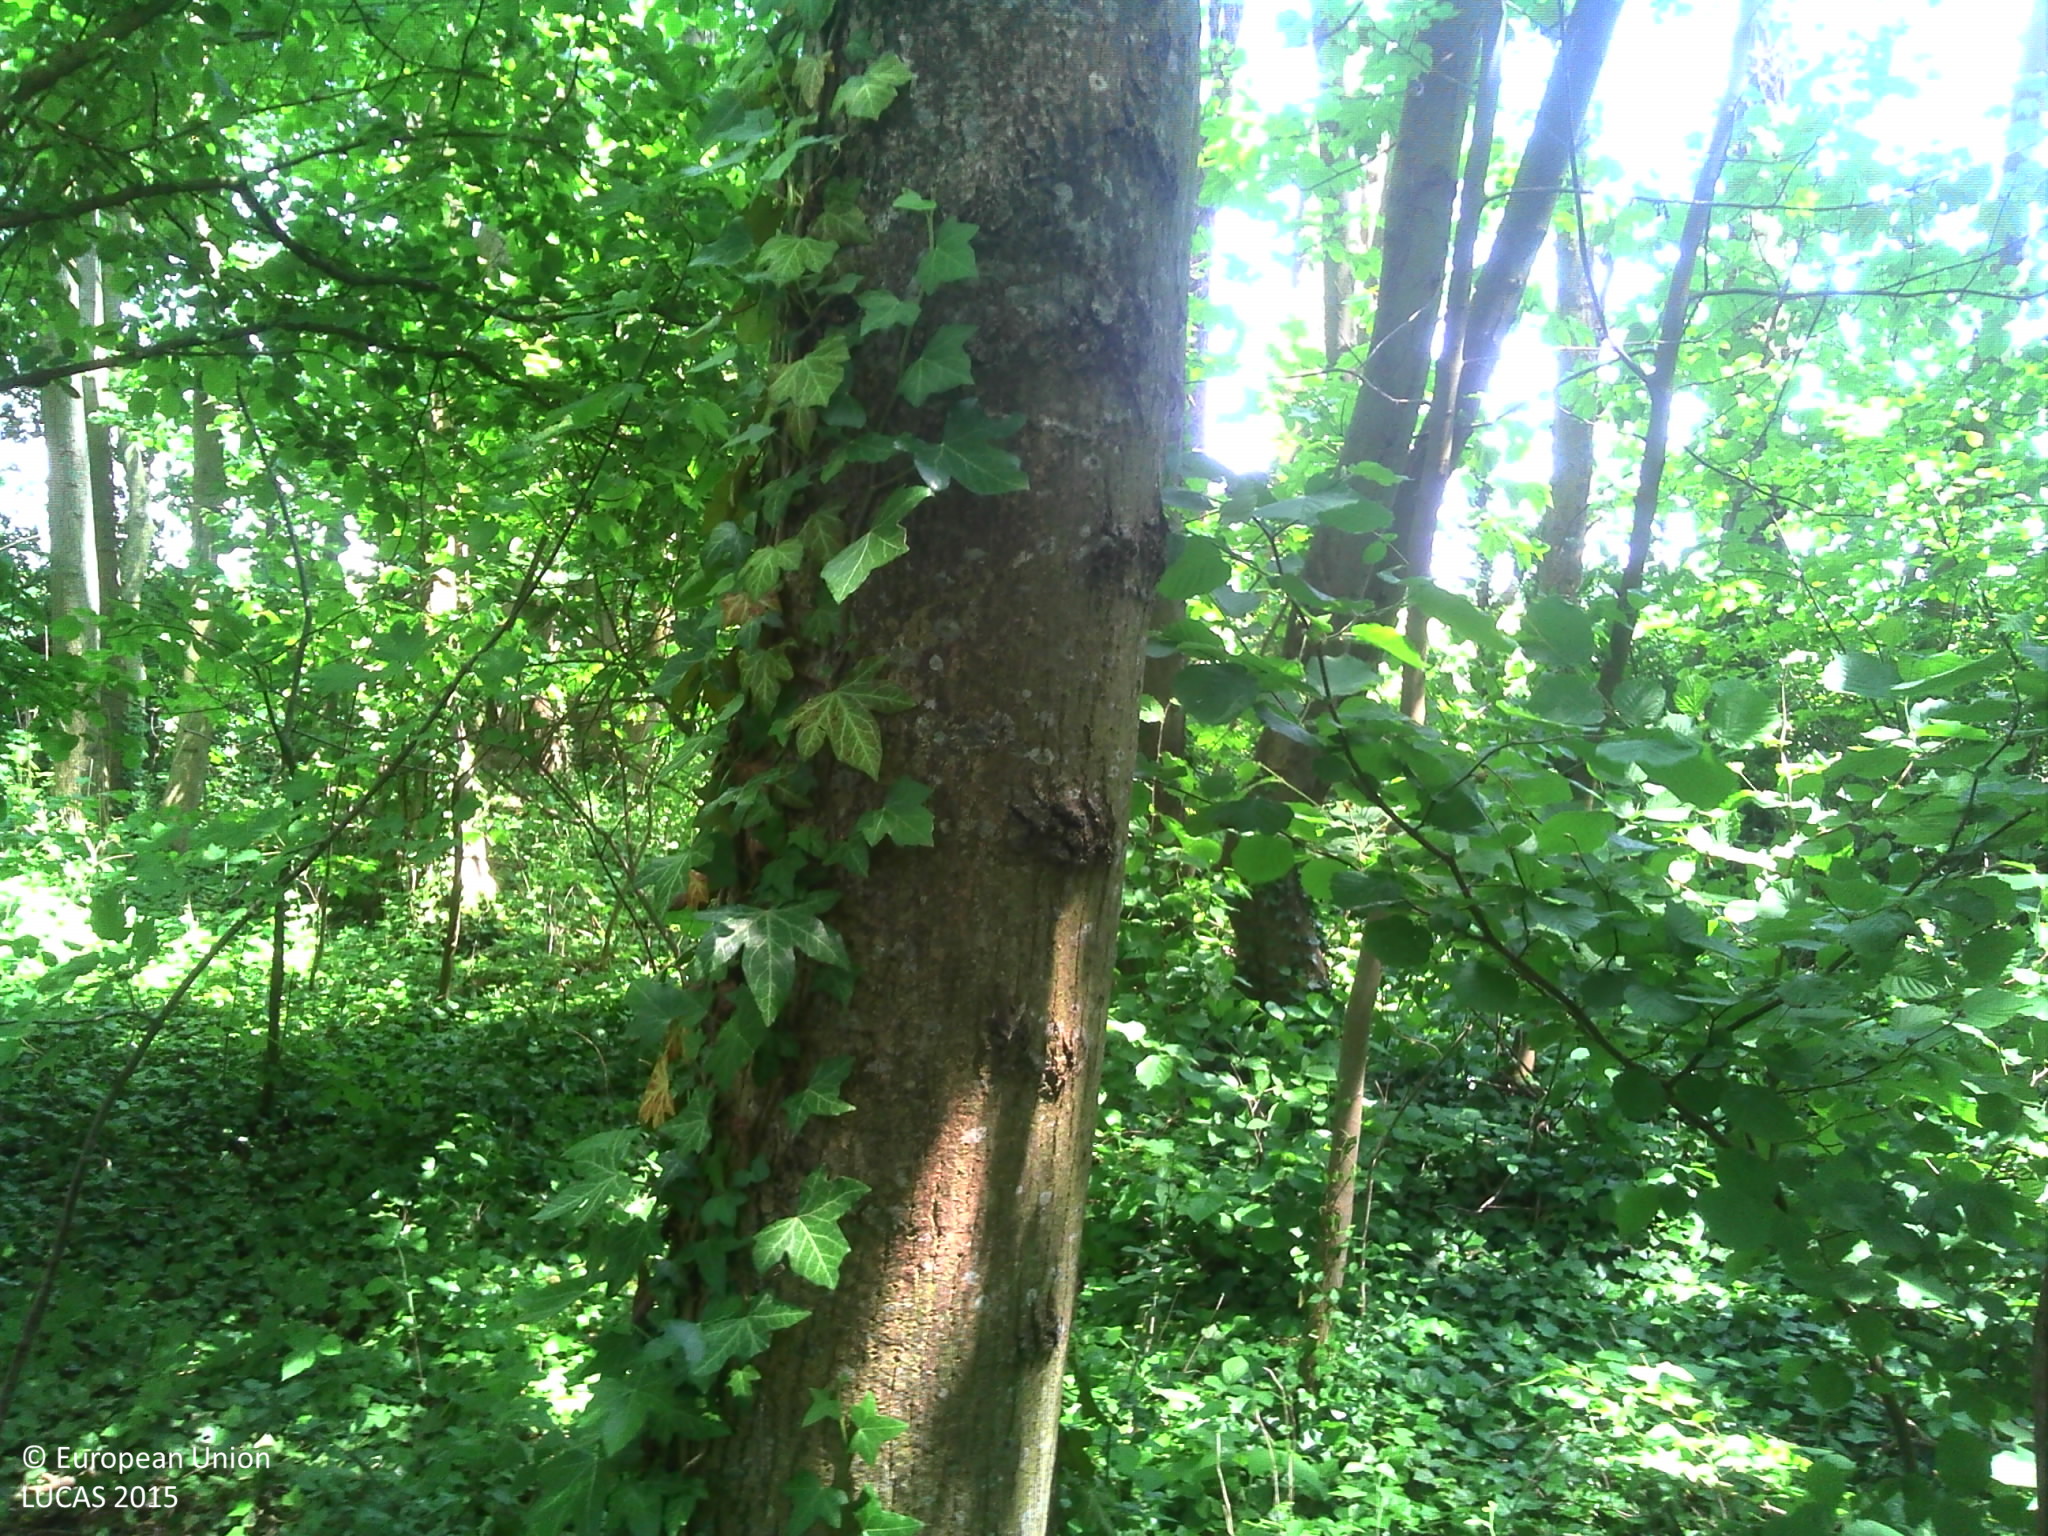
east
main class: Woodland
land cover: Broadleaved woodland
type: mesophytic deciduous forest
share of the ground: > 75 %
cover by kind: broadleaved forest trees 90 %, shrubs 5 %, herbaceous plants 5 %
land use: Semi-natural and natural areas not in use
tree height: > 5 m
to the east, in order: Broadleaved woodland; Ditches and canals; Grassland without tree/shrub cover; Common wheat
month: June
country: FR
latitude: 49.5608
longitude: 4.0639
